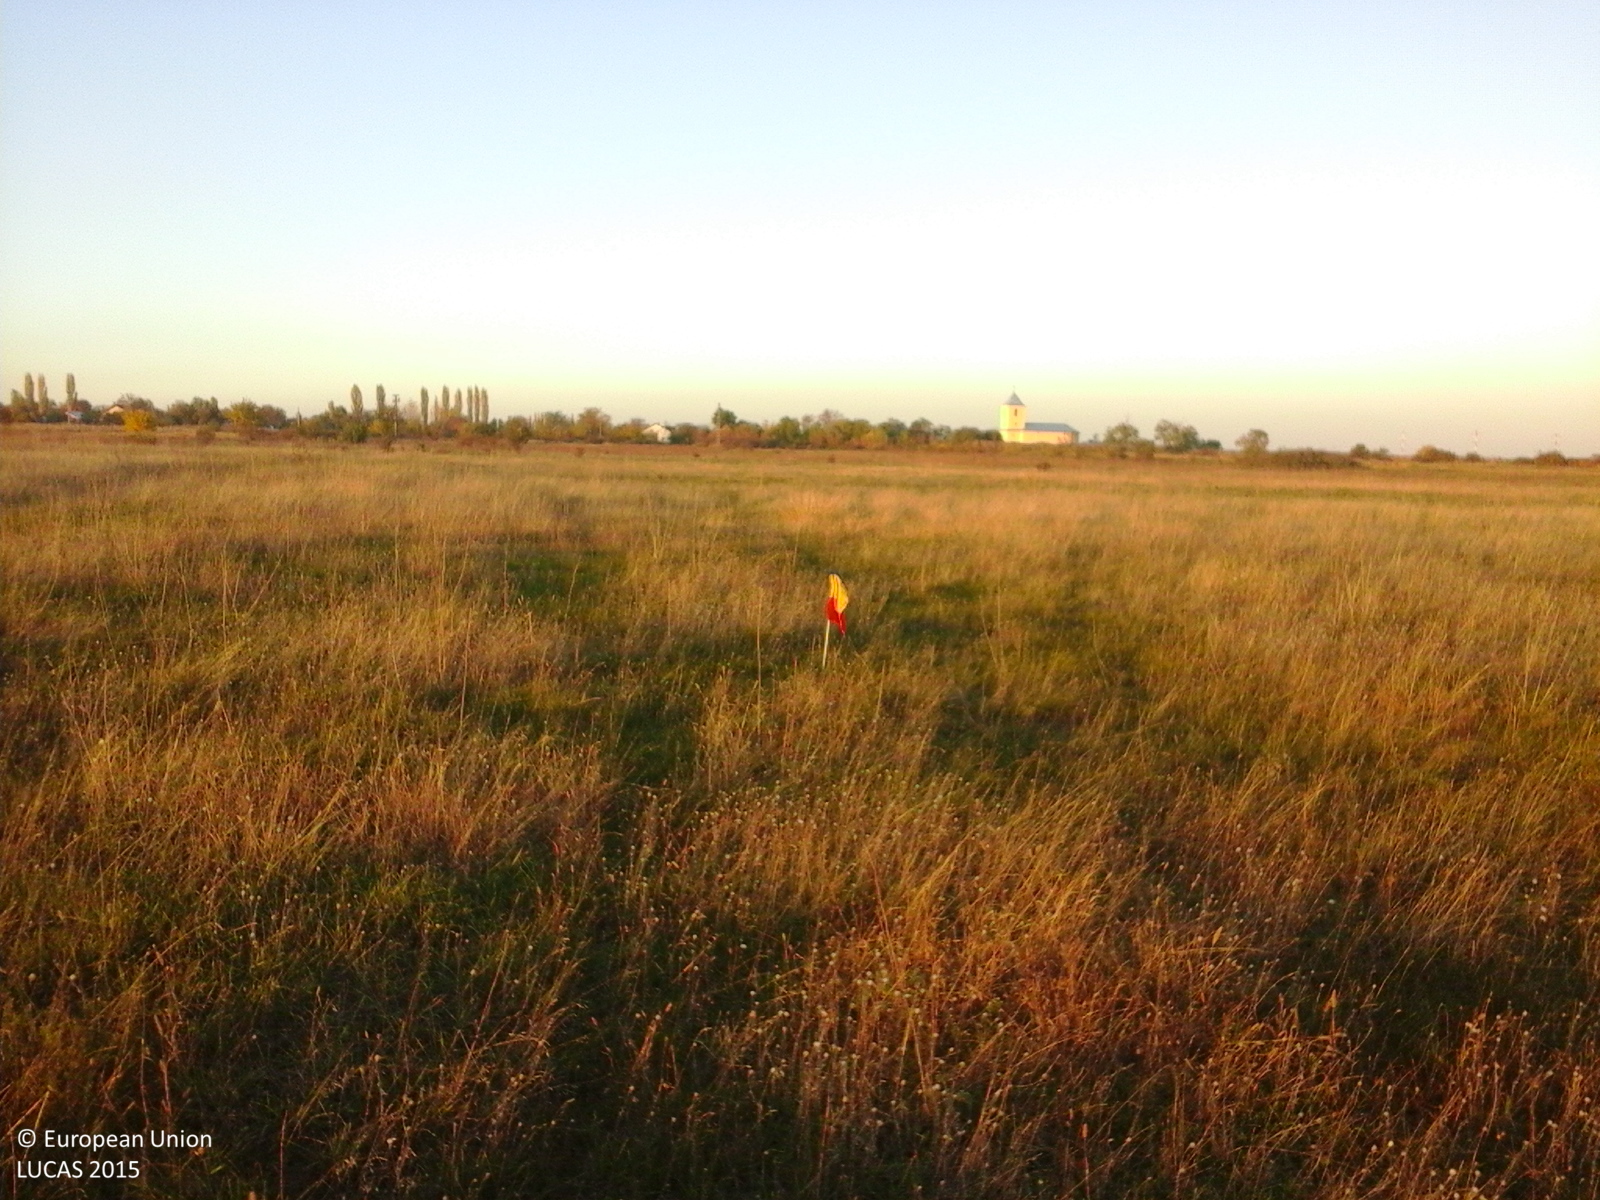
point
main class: Grassland
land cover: Grassland without tree/shrub cover
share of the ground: > 75 %
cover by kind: herbaceous plants 100 %
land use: Agriculture (excluding fallow land and kitchen gardens)
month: October
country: RO
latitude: 45.8003
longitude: 27.1422
